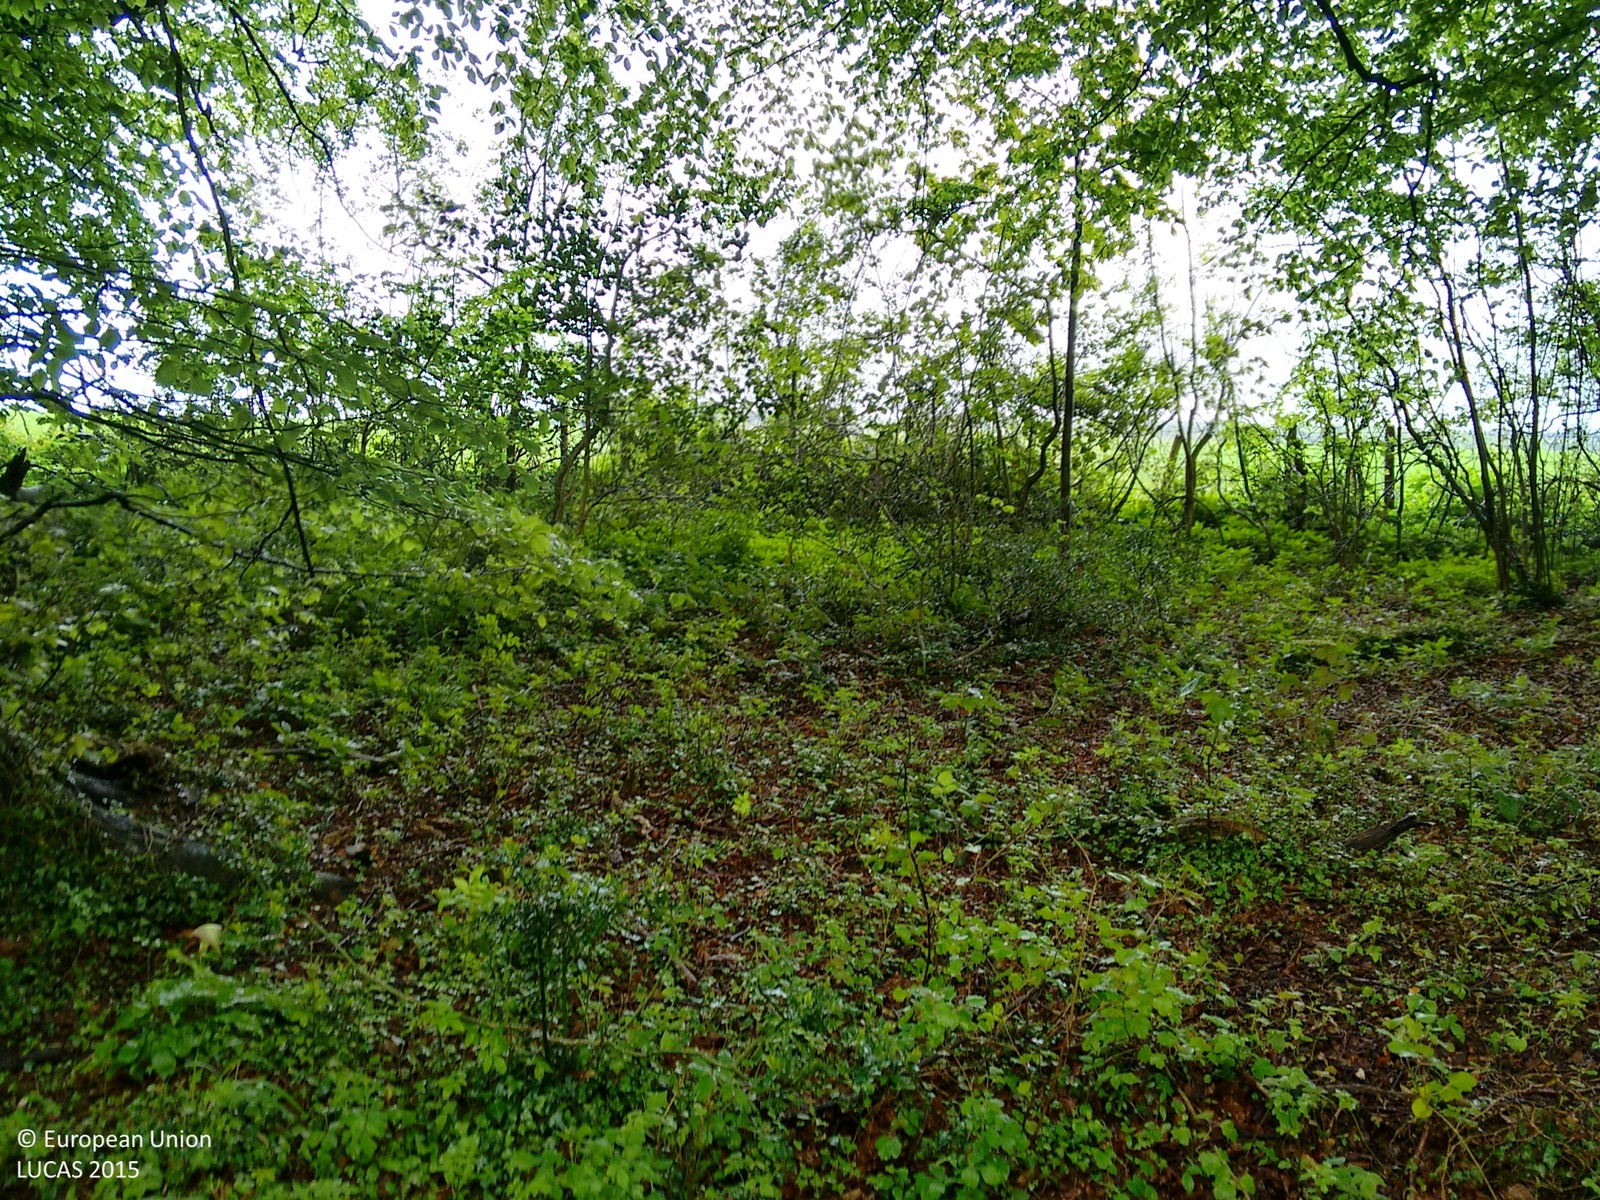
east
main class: Woodland
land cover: Broadleaved woodland
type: beech forest
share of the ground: > 75 %
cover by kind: broadleaved forest trees 100 %
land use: Semi-natural and natural areas not in use
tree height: > 5 m
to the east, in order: Broadleaved woodland; Fences; Spontaneously vegetated surfaces; Barley; Spontaneously vegetated surfaces; Fences; Managed hedges; Grass margins; Paved roads, cycling and walking lanes; Grass margins; Broadleaved woodland
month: May
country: GB
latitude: 50.9632
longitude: -0.9359
